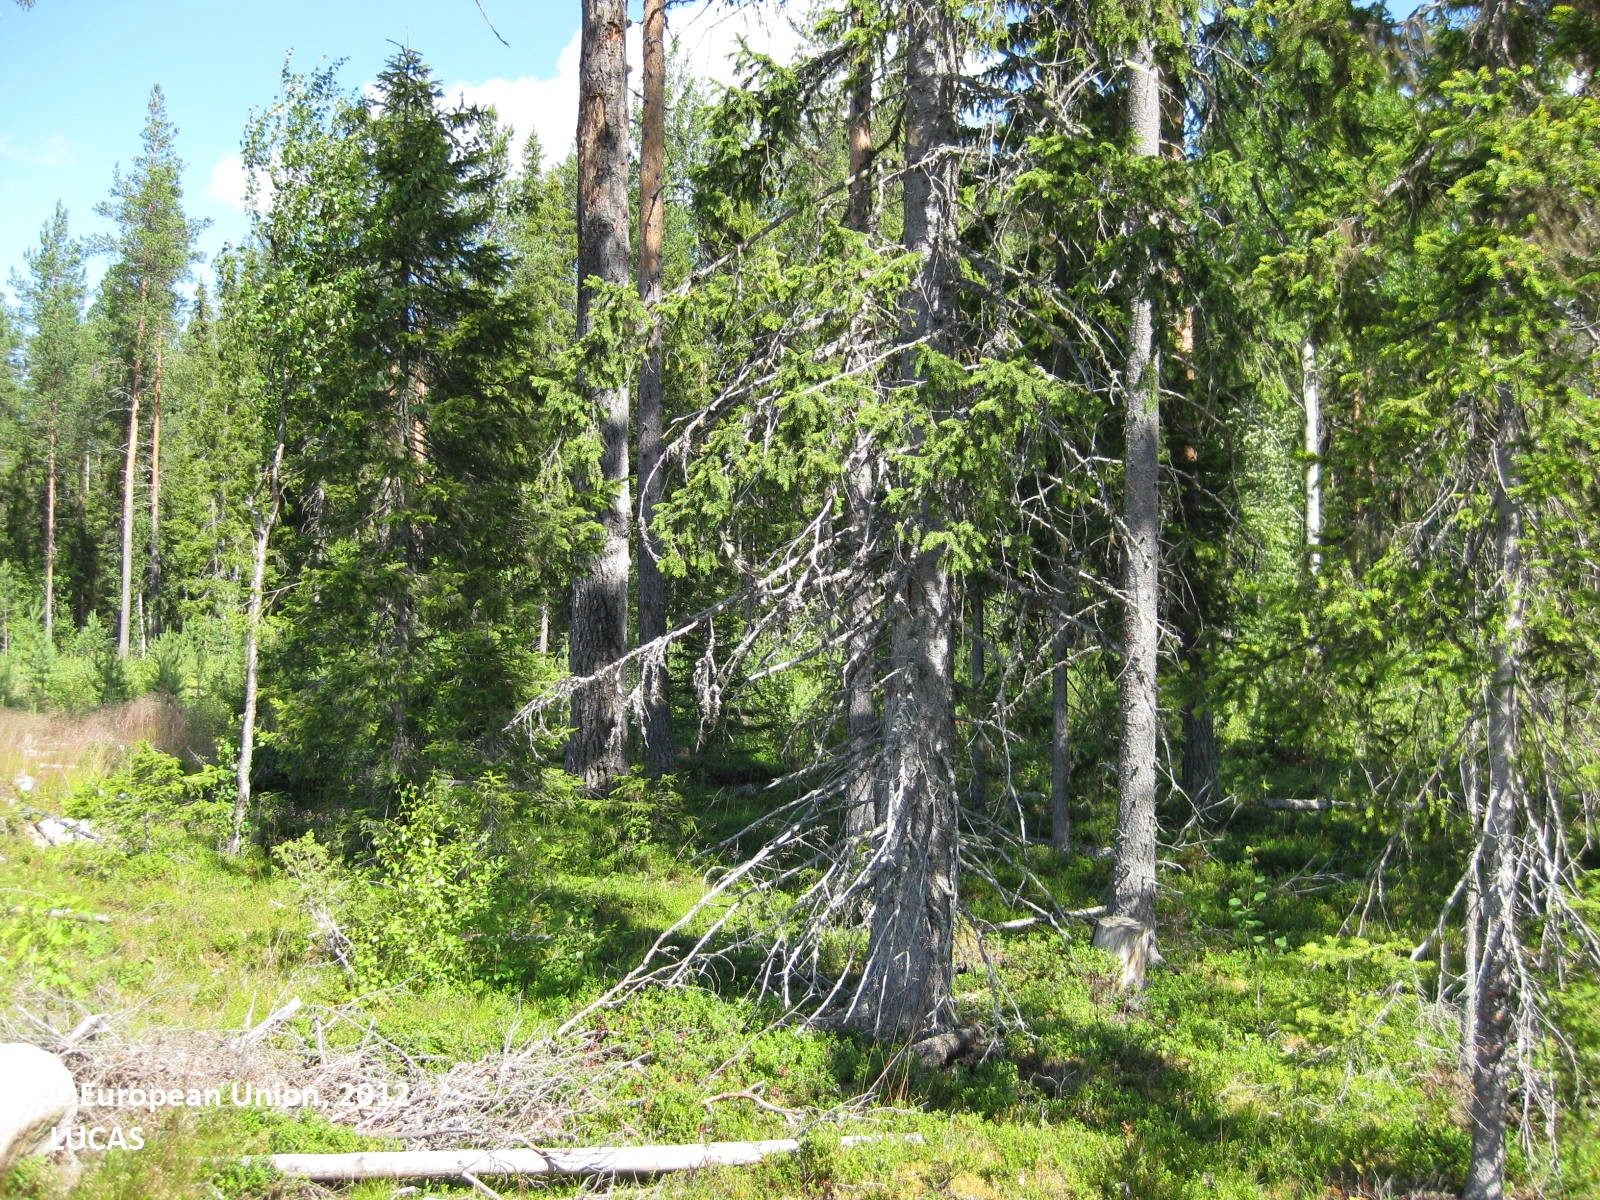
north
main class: Grassland
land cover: Grassland with sparse tree/shrub cover
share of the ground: > 75 %
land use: Forestry
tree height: < 5 m
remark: Clear cut
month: July
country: FI
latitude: 65.6830
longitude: 28.3705
